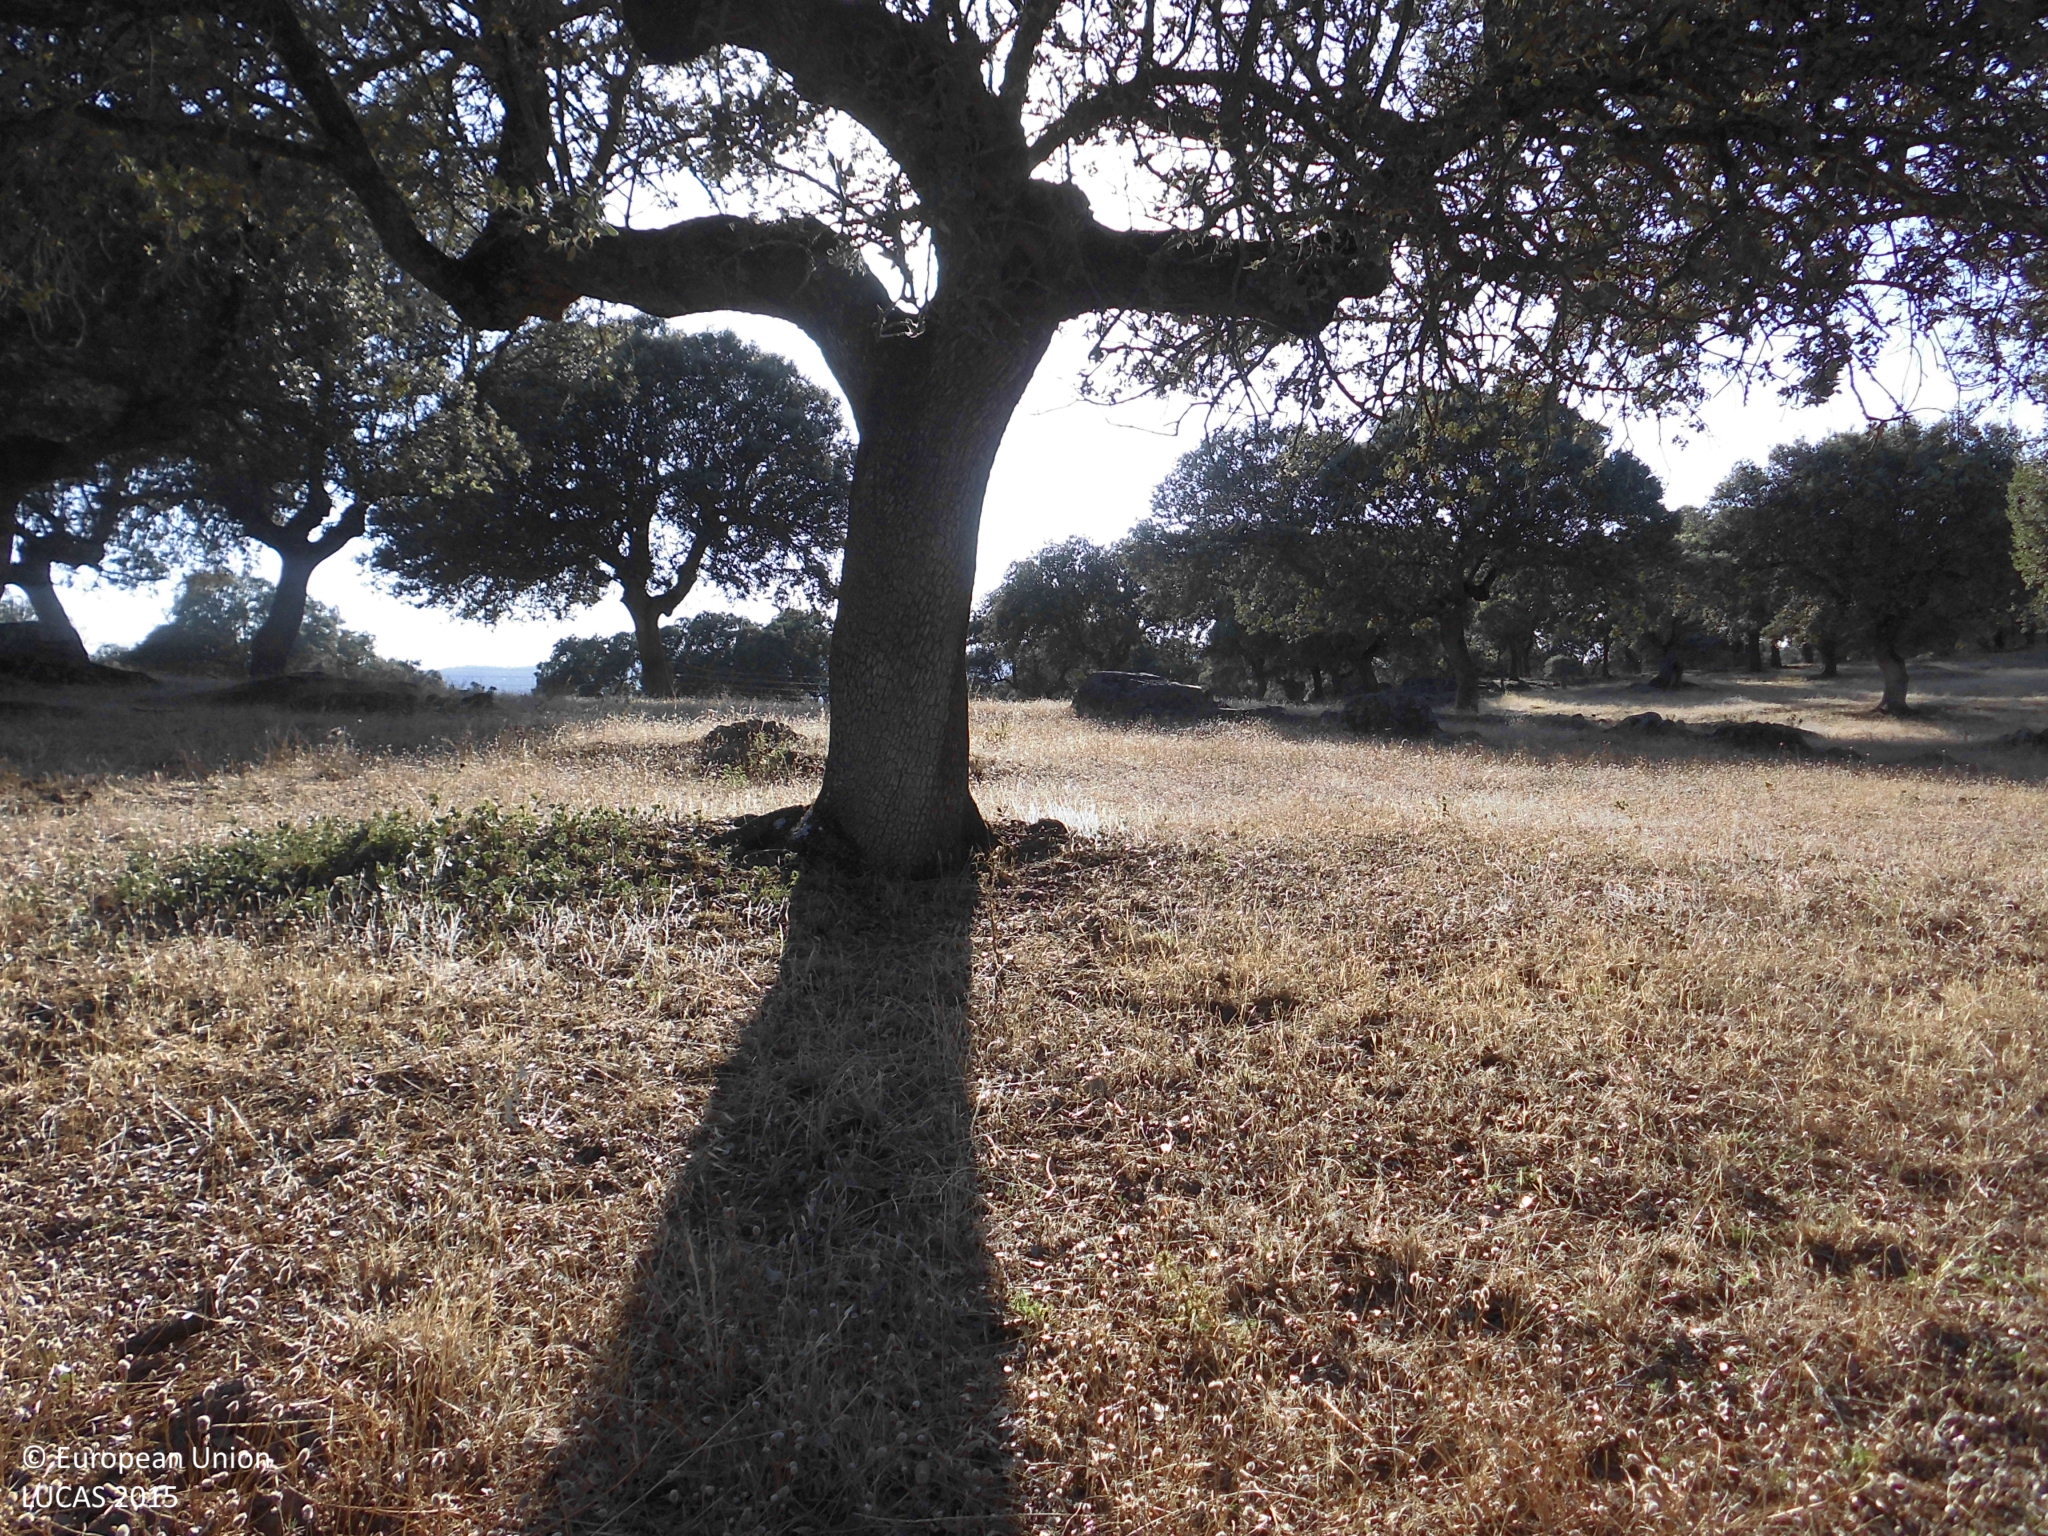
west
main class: Woodland
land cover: Broadleaved woodland
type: broadleaved evergreen forest
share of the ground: 25 - 50 %
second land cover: Grassland without tree/shrub cover
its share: > 75 %
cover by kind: broadleaved forest trees 50 %, herbaceous plants 50 %
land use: Forestry
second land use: Agriculture (excluding fallow land and kitchen gardens)
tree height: > 5 m
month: July
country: ES
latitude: 39.4928
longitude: -5.5762
